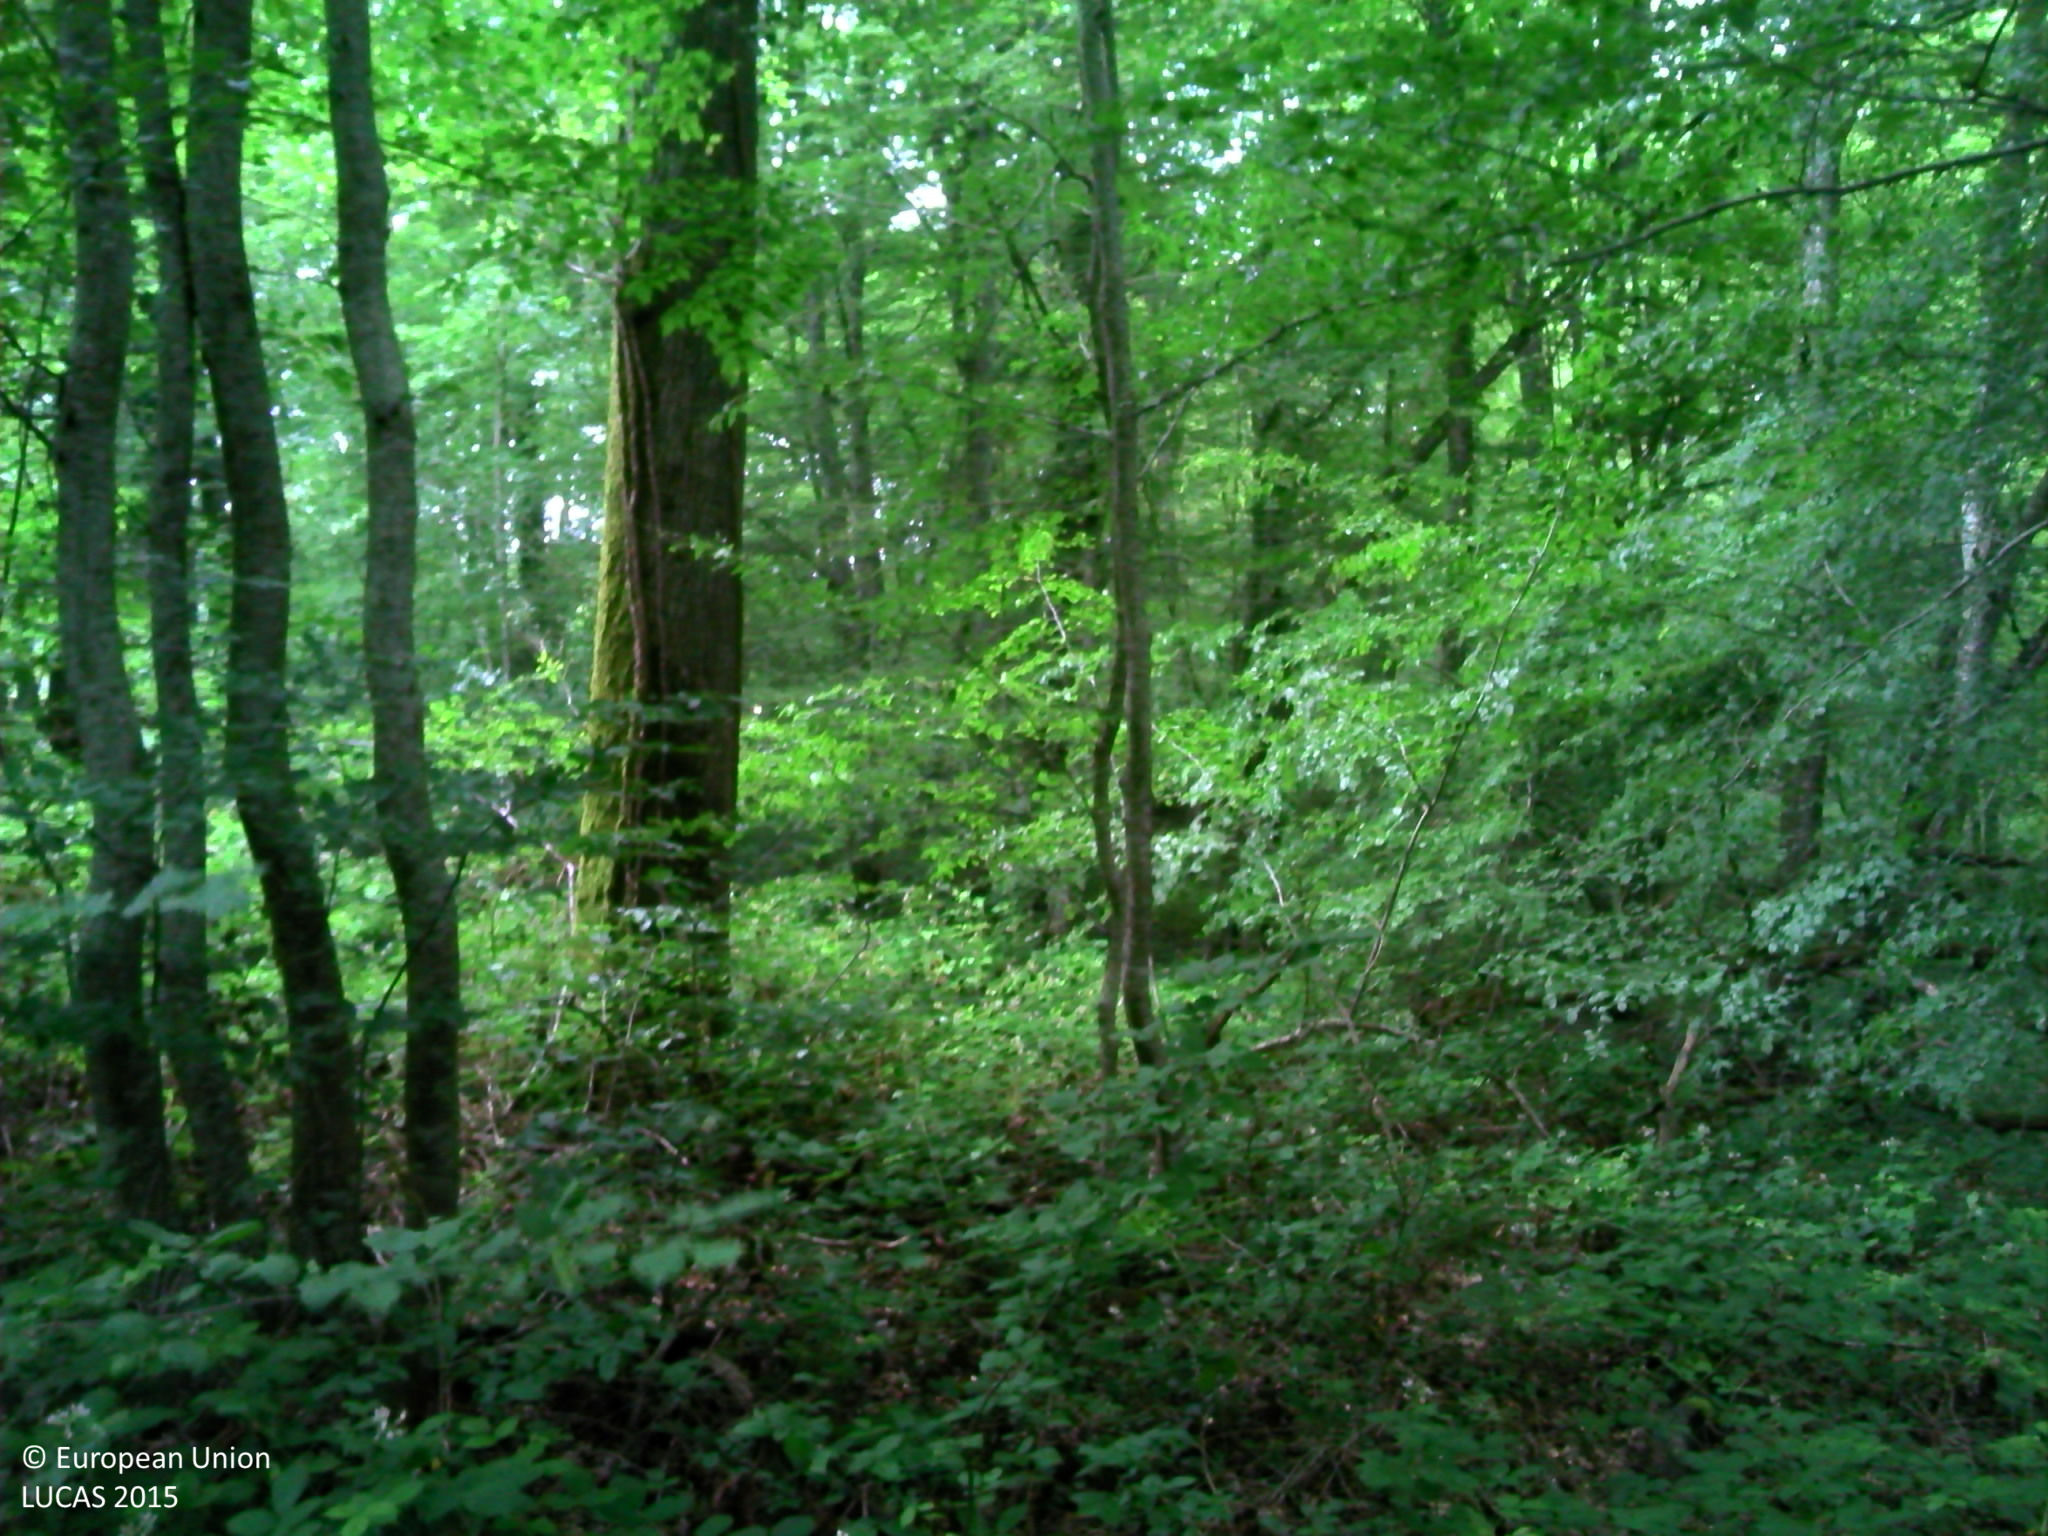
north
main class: Woodland
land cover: Broadleaved woodland
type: mesophytic deciduous forest
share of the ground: > 75 %
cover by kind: broadleaved forest trees 100 %
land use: Forestry
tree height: > 5 m
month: June
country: FR
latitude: 47.5556
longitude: 3.0974
